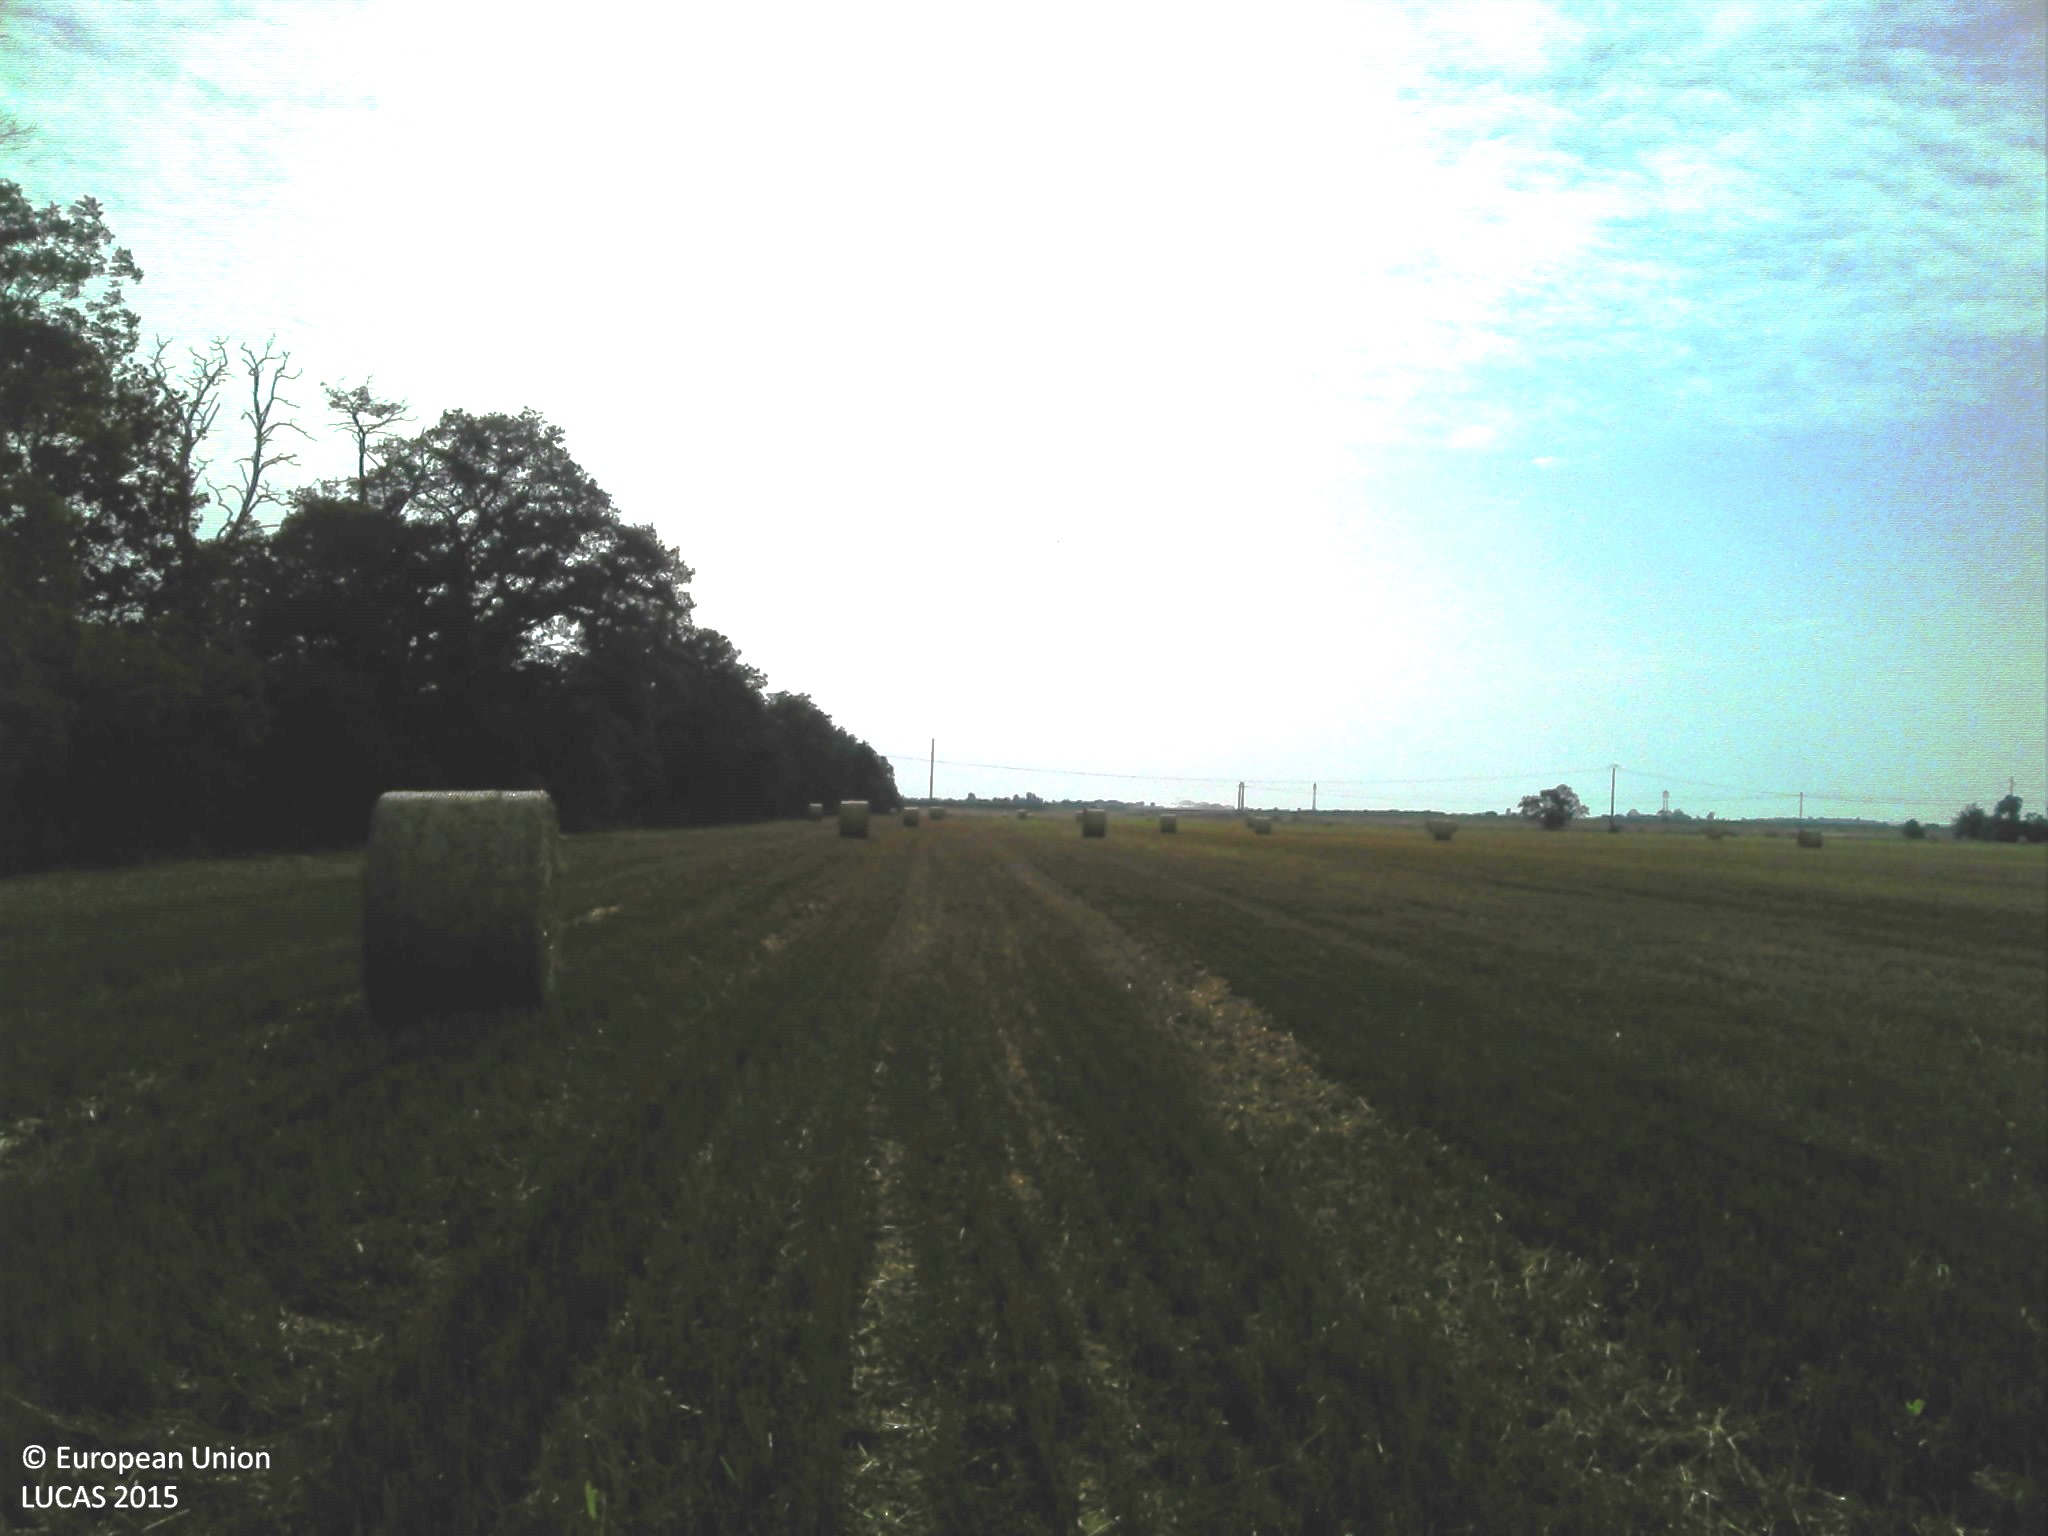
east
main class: Cropland
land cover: Common wheat
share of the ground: > 75 %
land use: Agriculture (excluding fallow land and kitchen gardens)
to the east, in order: Common wheat
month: July
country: FR
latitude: 43.2136
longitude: 1.6228
